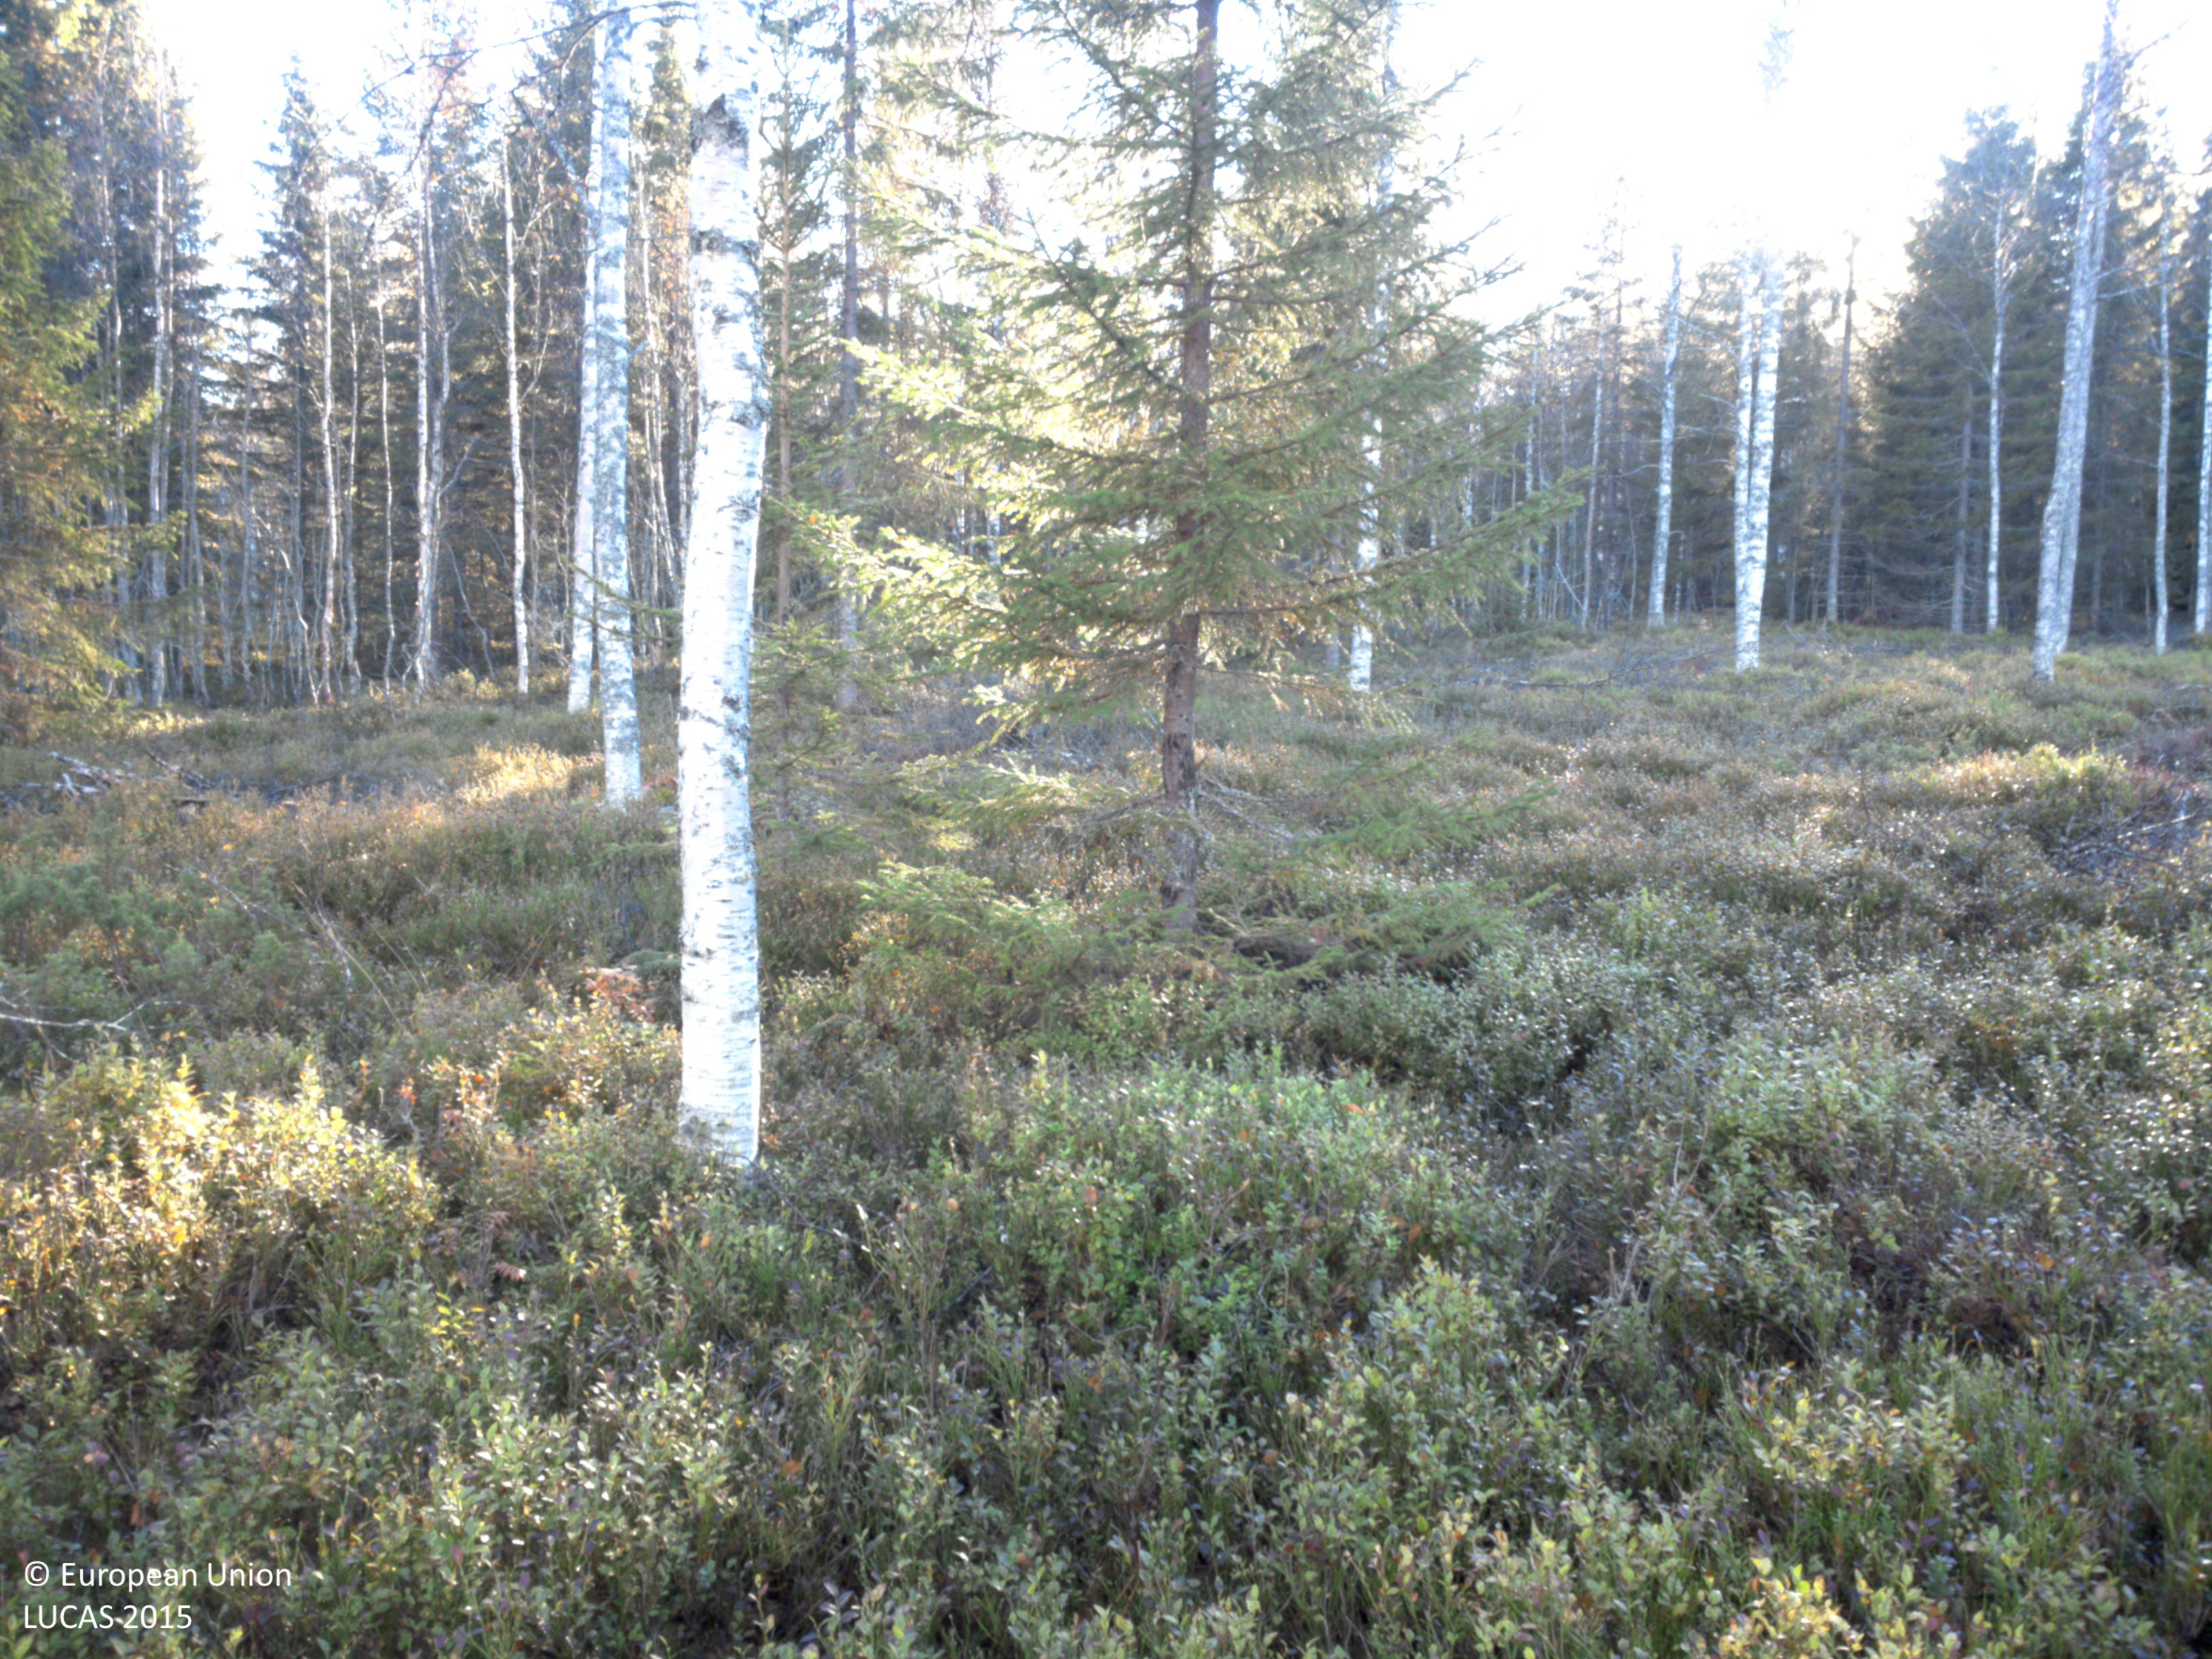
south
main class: Woodland
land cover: Spruce dominated mixed woodland
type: boreal forest
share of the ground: 50 - 75 %
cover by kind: coniferous forest trees 50 %, broadleaved forest trees 25 %, shrubs 15 %, herbaceous plants 5 %, lichens and mosses 5 %
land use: Forestry
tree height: > 5 m
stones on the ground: < 10 %
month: October
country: SE
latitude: 64.0781
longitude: 18.8505
